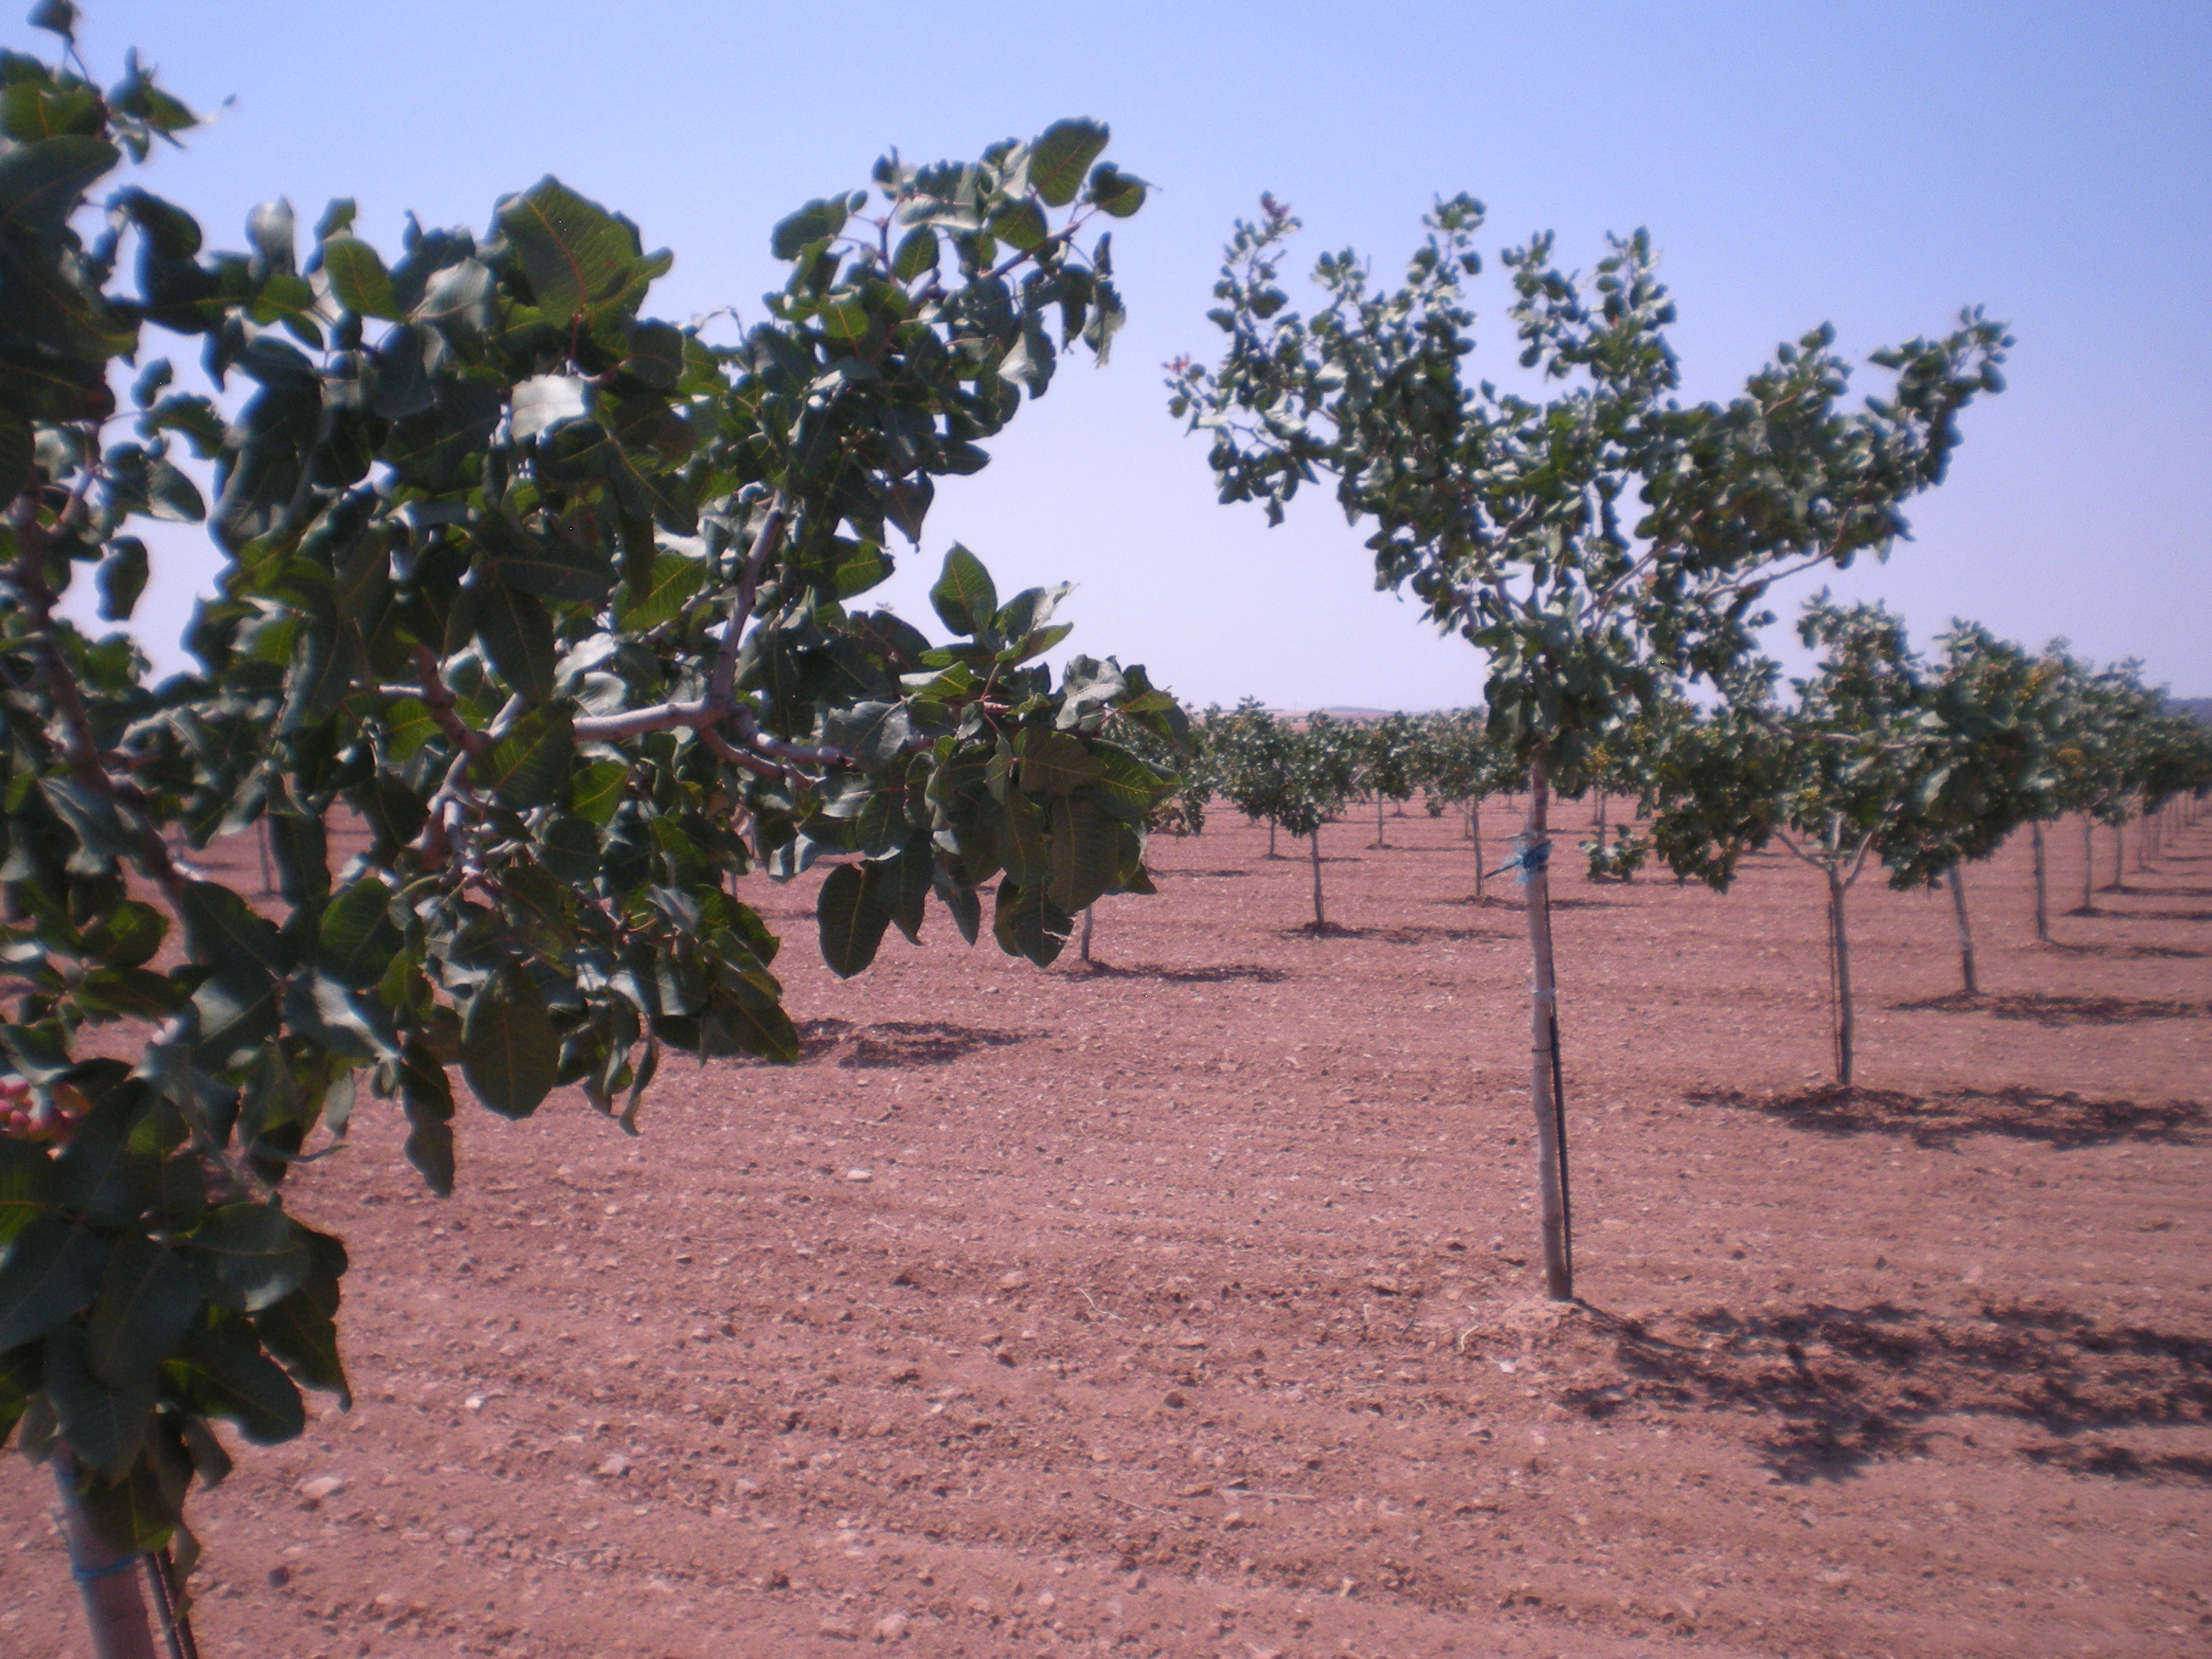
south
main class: Cropland
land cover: Nuts trees
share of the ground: < 10 %
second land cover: Other bare soil
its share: > 75 %
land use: Agriculture (excluding fallow land and kitchen gardens)
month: June
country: ES
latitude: 39.5816
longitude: -3.3999
